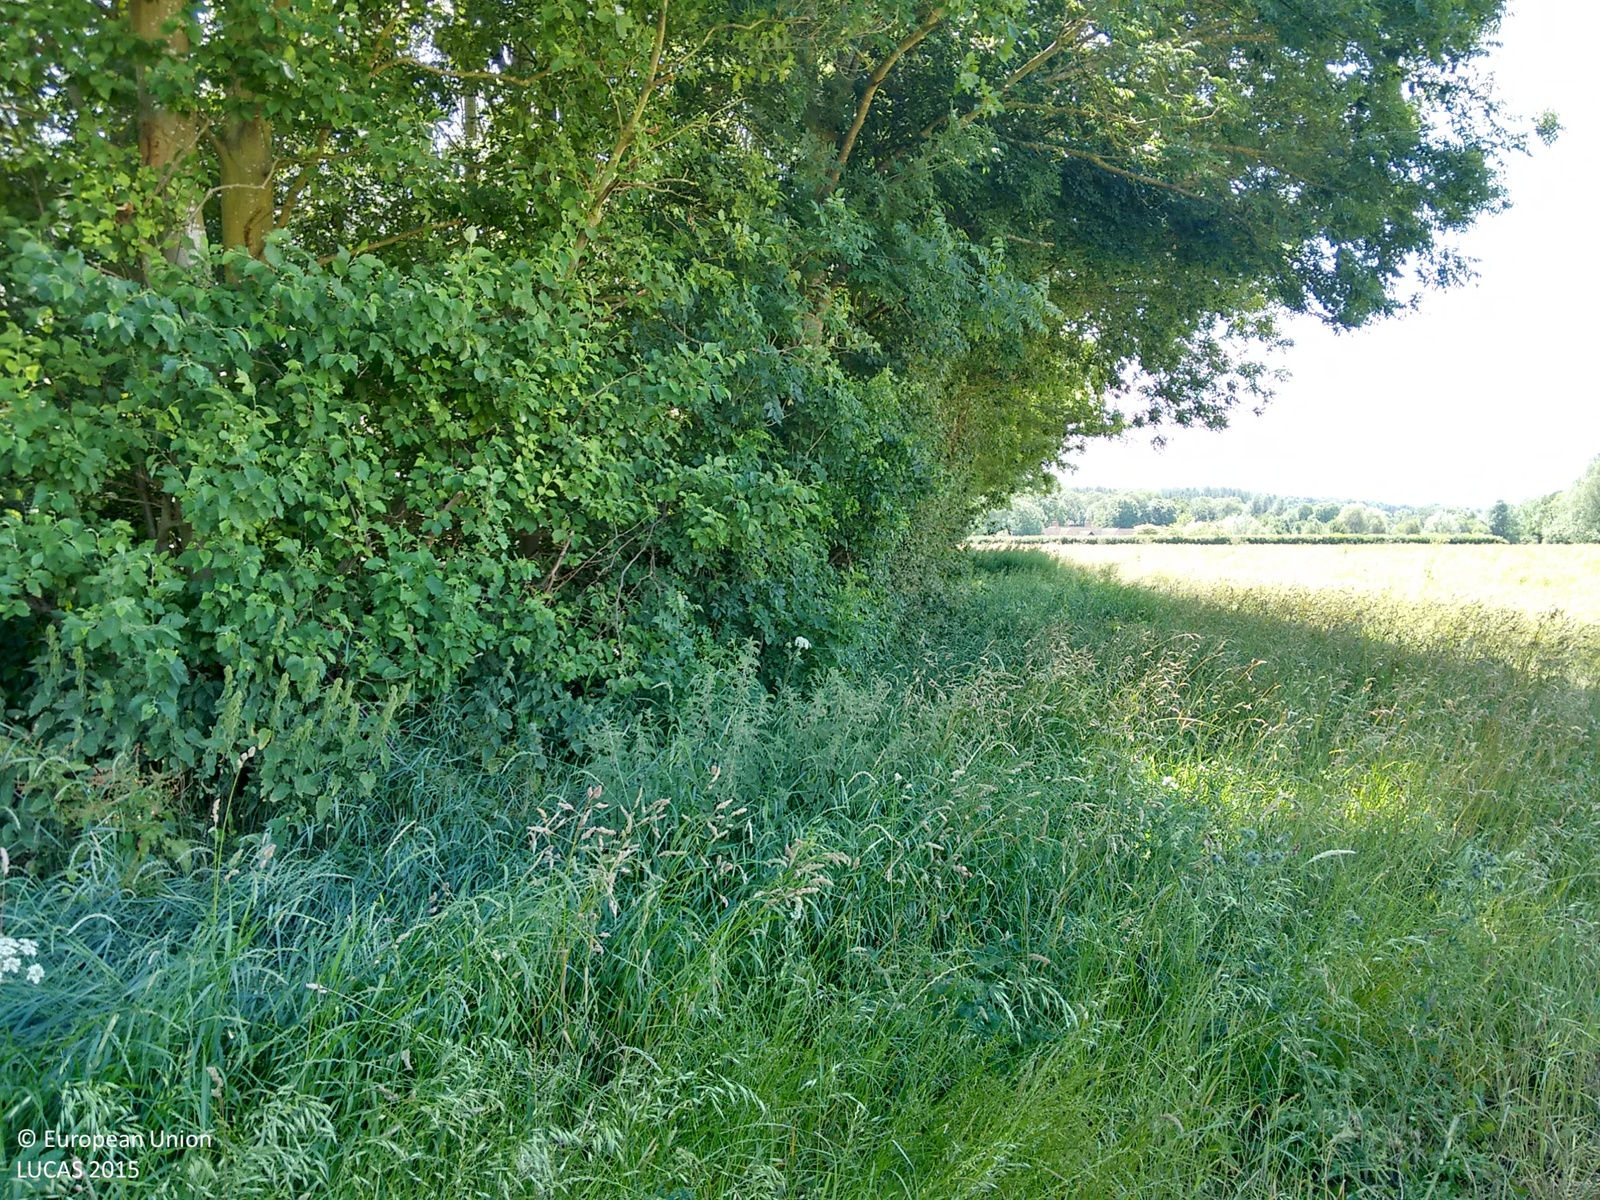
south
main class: Cropland
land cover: Rape and turnip rape
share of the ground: > 75 %
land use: Agriculture (excluding fallow land and kitchen gardens)
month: July
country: GB
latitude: 51.6796
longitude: -1.2270
